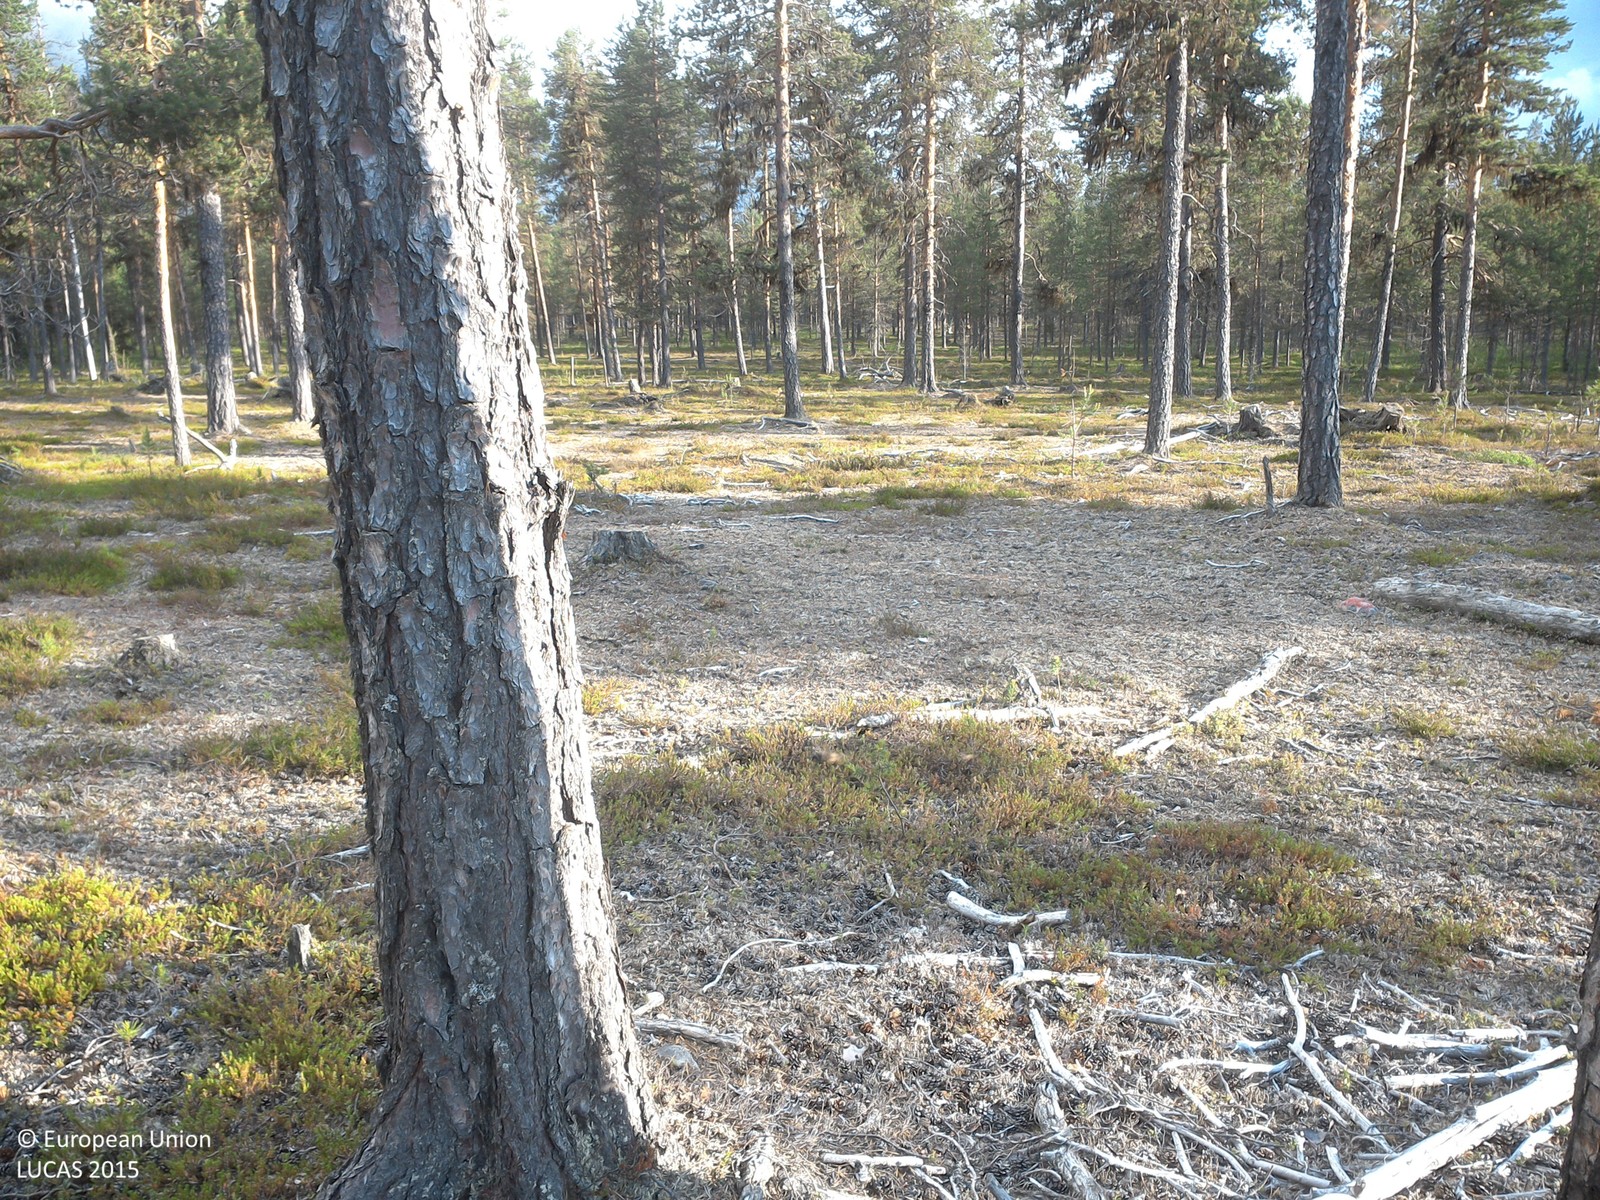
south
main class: Woodland
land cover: Pine dominated coniferous woodland
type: boreal forest
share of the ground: 10 - 25 %
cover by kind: lichens and mosses 45 %, shrubs 35 %, coniferous forest trees 20 %
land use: Forestry
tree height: > 5 m
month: July
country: SE
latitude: 67.7465
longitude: 23.4282
